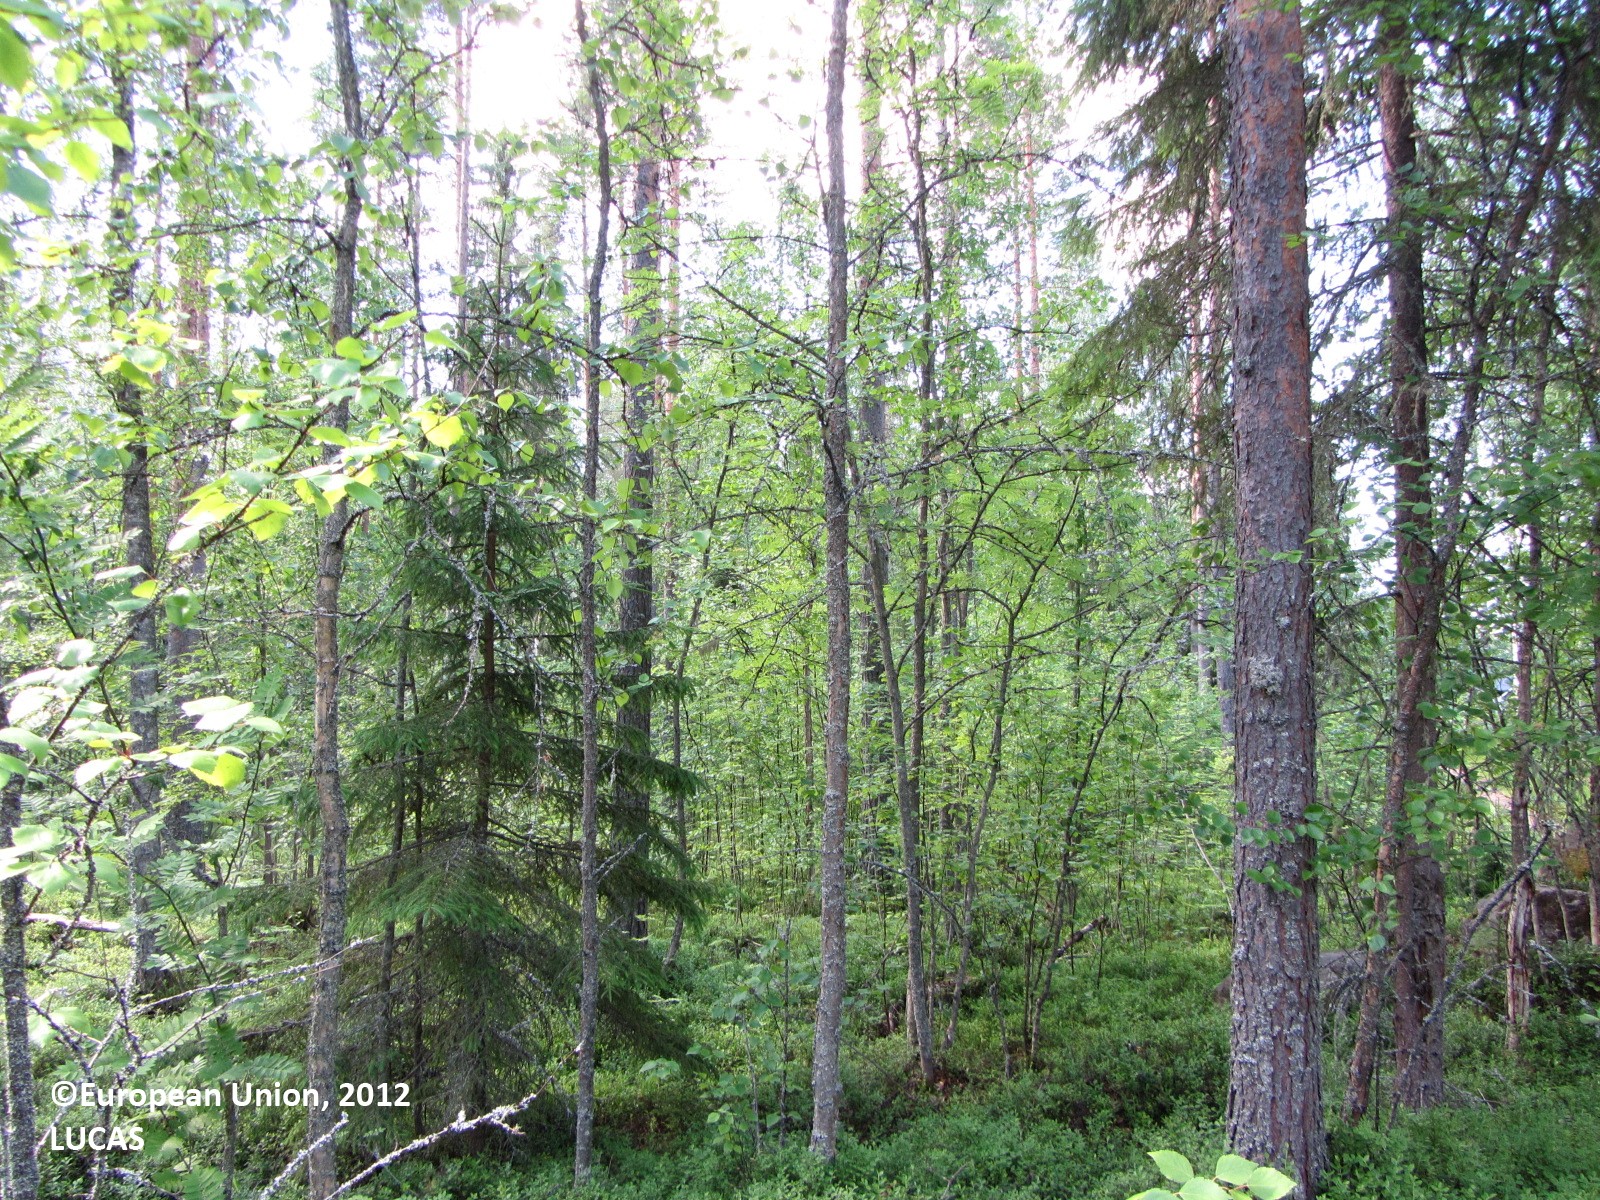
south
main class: Woodland
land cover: Other coniferous woodland
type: boreal forest
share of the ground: 50 - 75 %
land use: Forestry
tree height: > 5 m
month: July
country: FI
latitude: 62.9427
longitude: 25.1742
